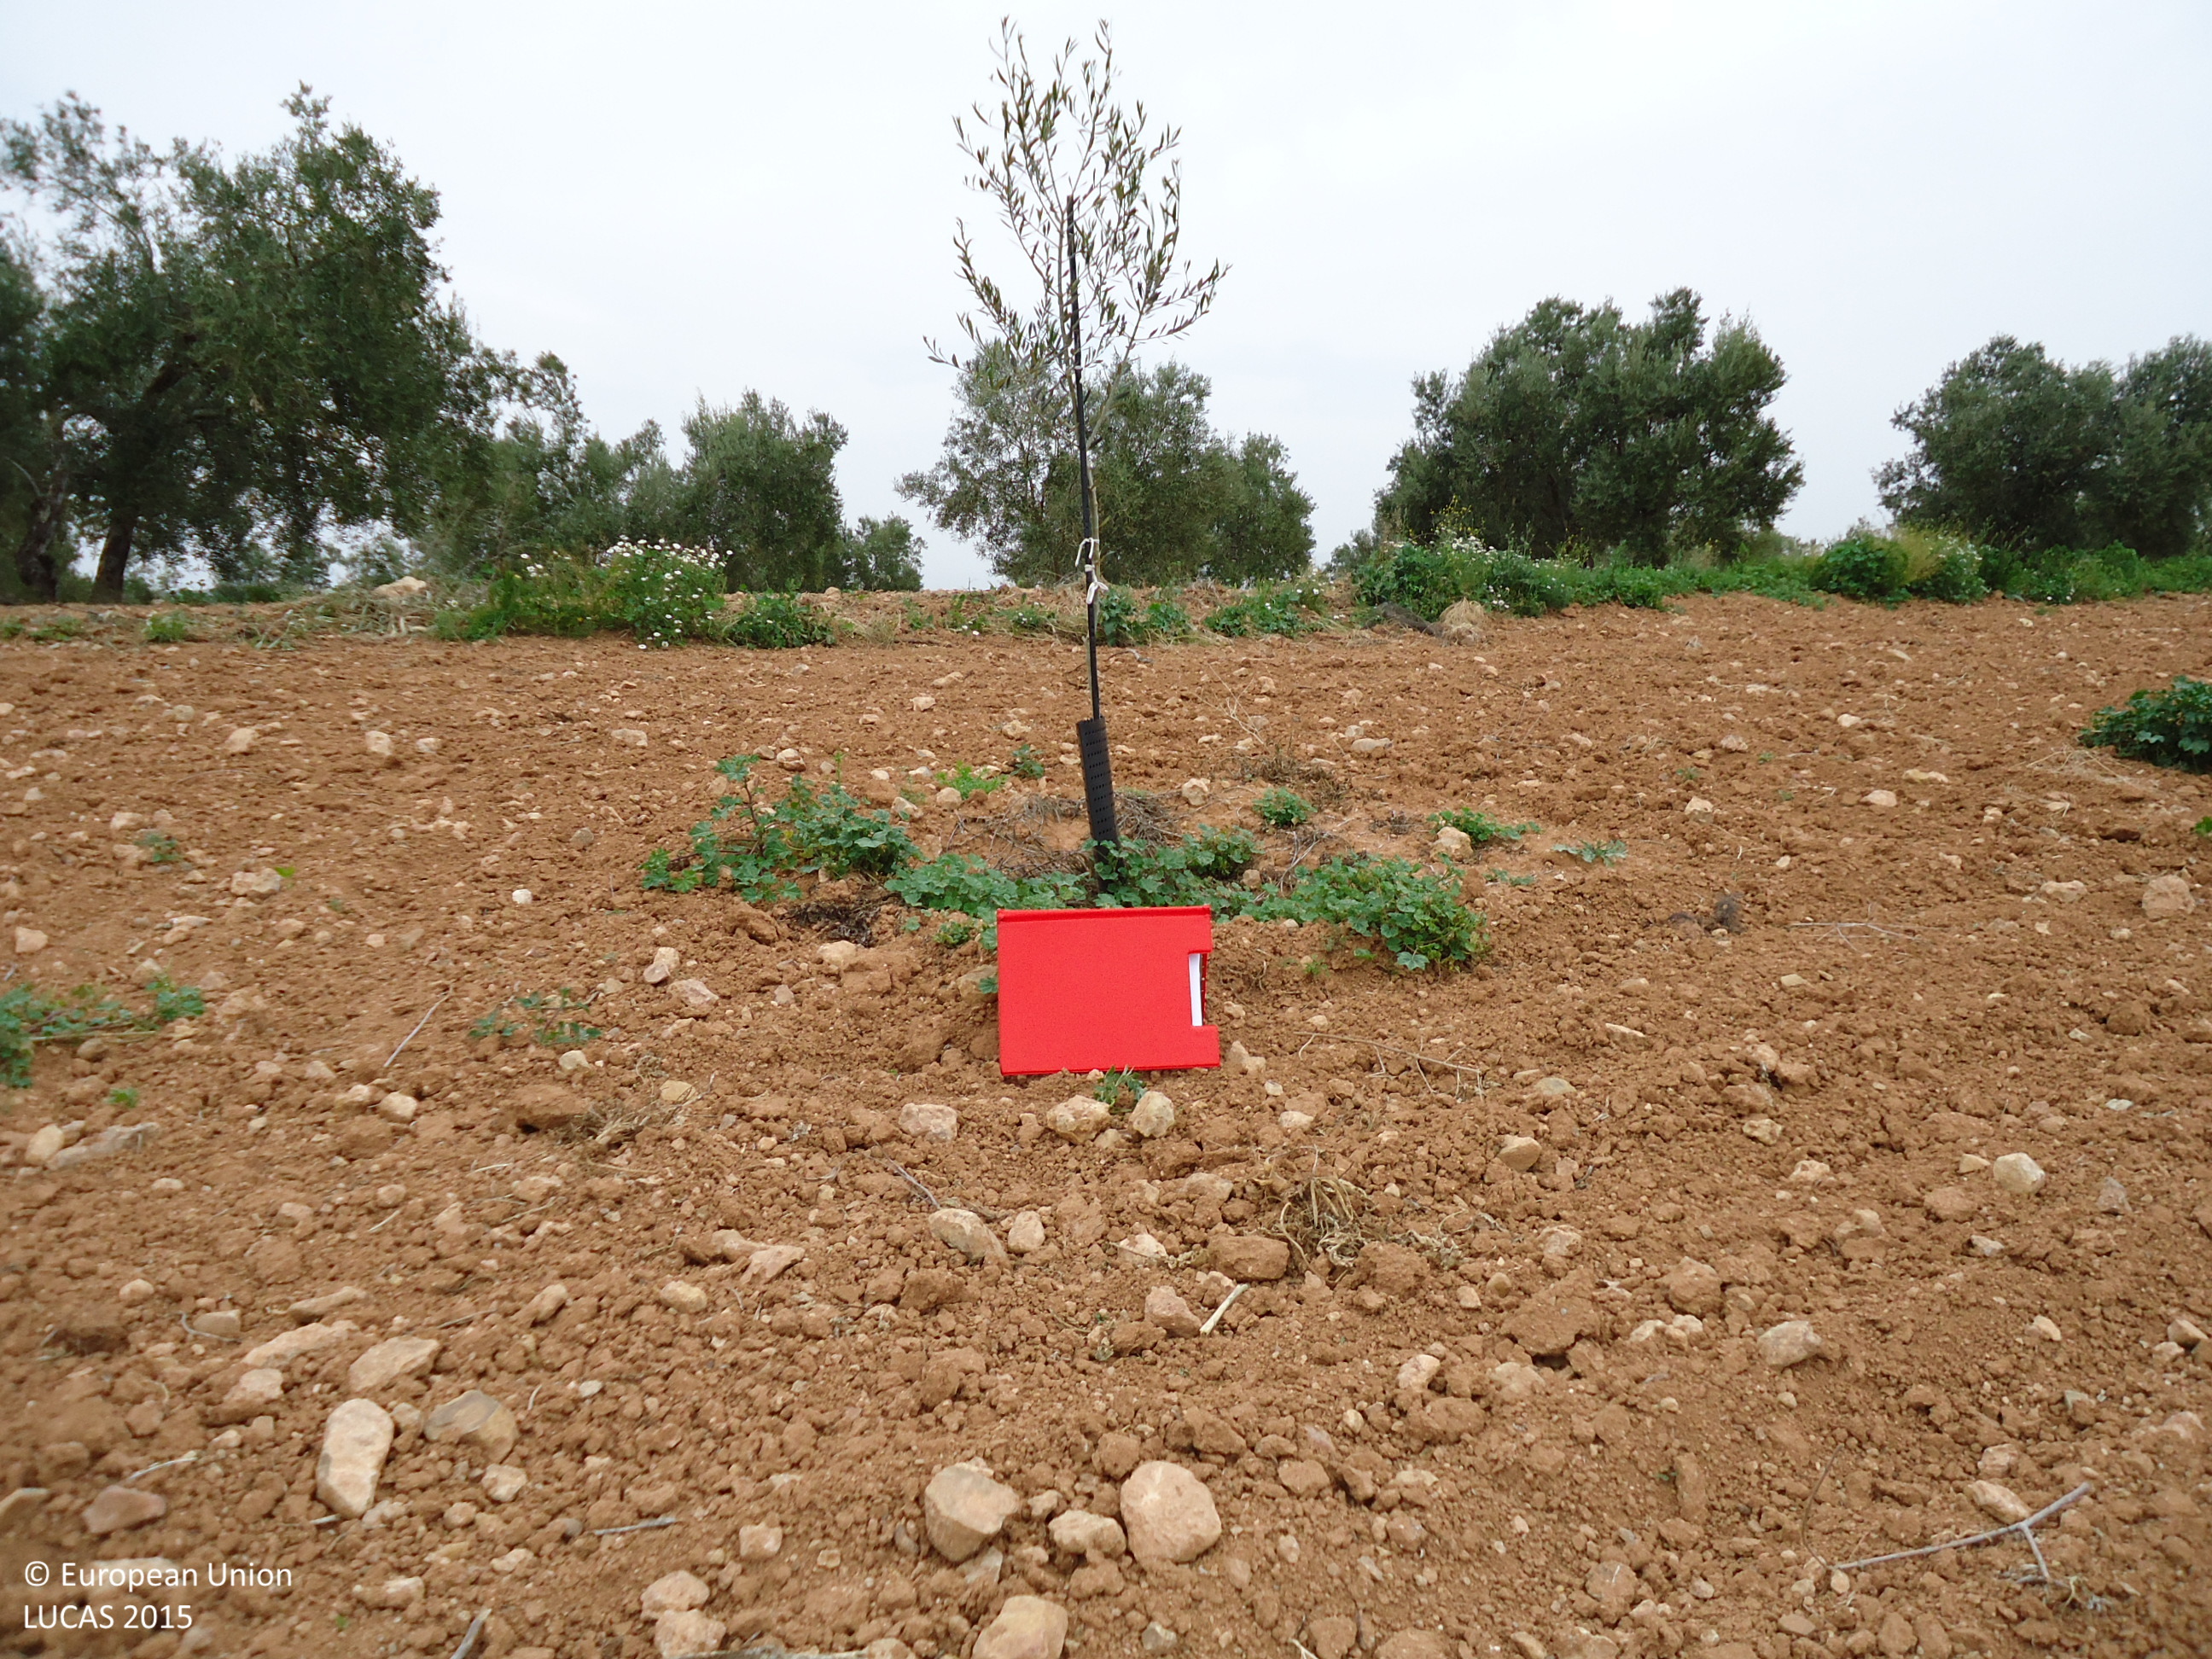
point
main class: Cropland
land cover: Olive groves
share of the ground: < 10 %
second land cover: Other bare soil
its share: > 75 %
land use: Agriculture (excluding fallow land and kitchen gardens)
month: April
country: ES
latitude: 37.0098
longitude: -5.0054
